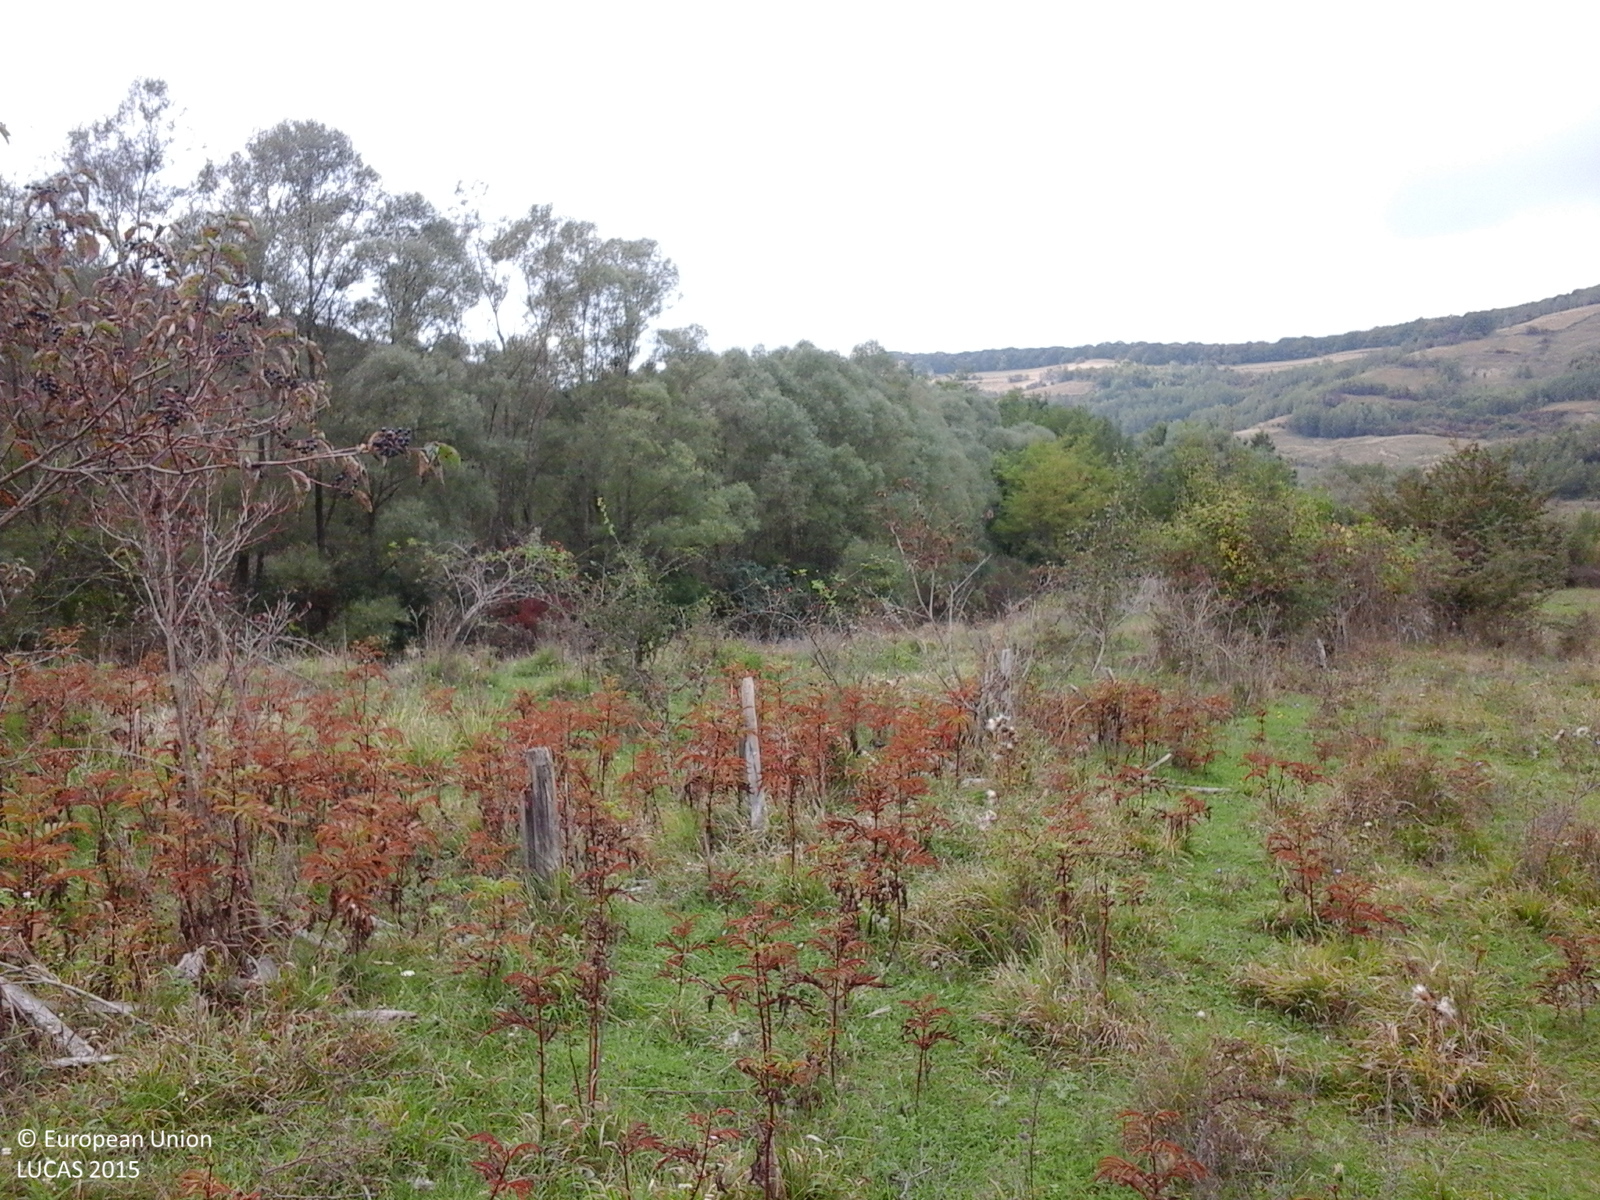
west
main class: Grassland
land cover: Spontaneously vegetated surfaces
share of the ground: > 75 %
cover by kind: herbaceous plants 100 %
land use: Agriculture (excluding fallow land and kitchen gardens)
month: October
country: RO
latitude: 46.1469
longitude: 24.2033
